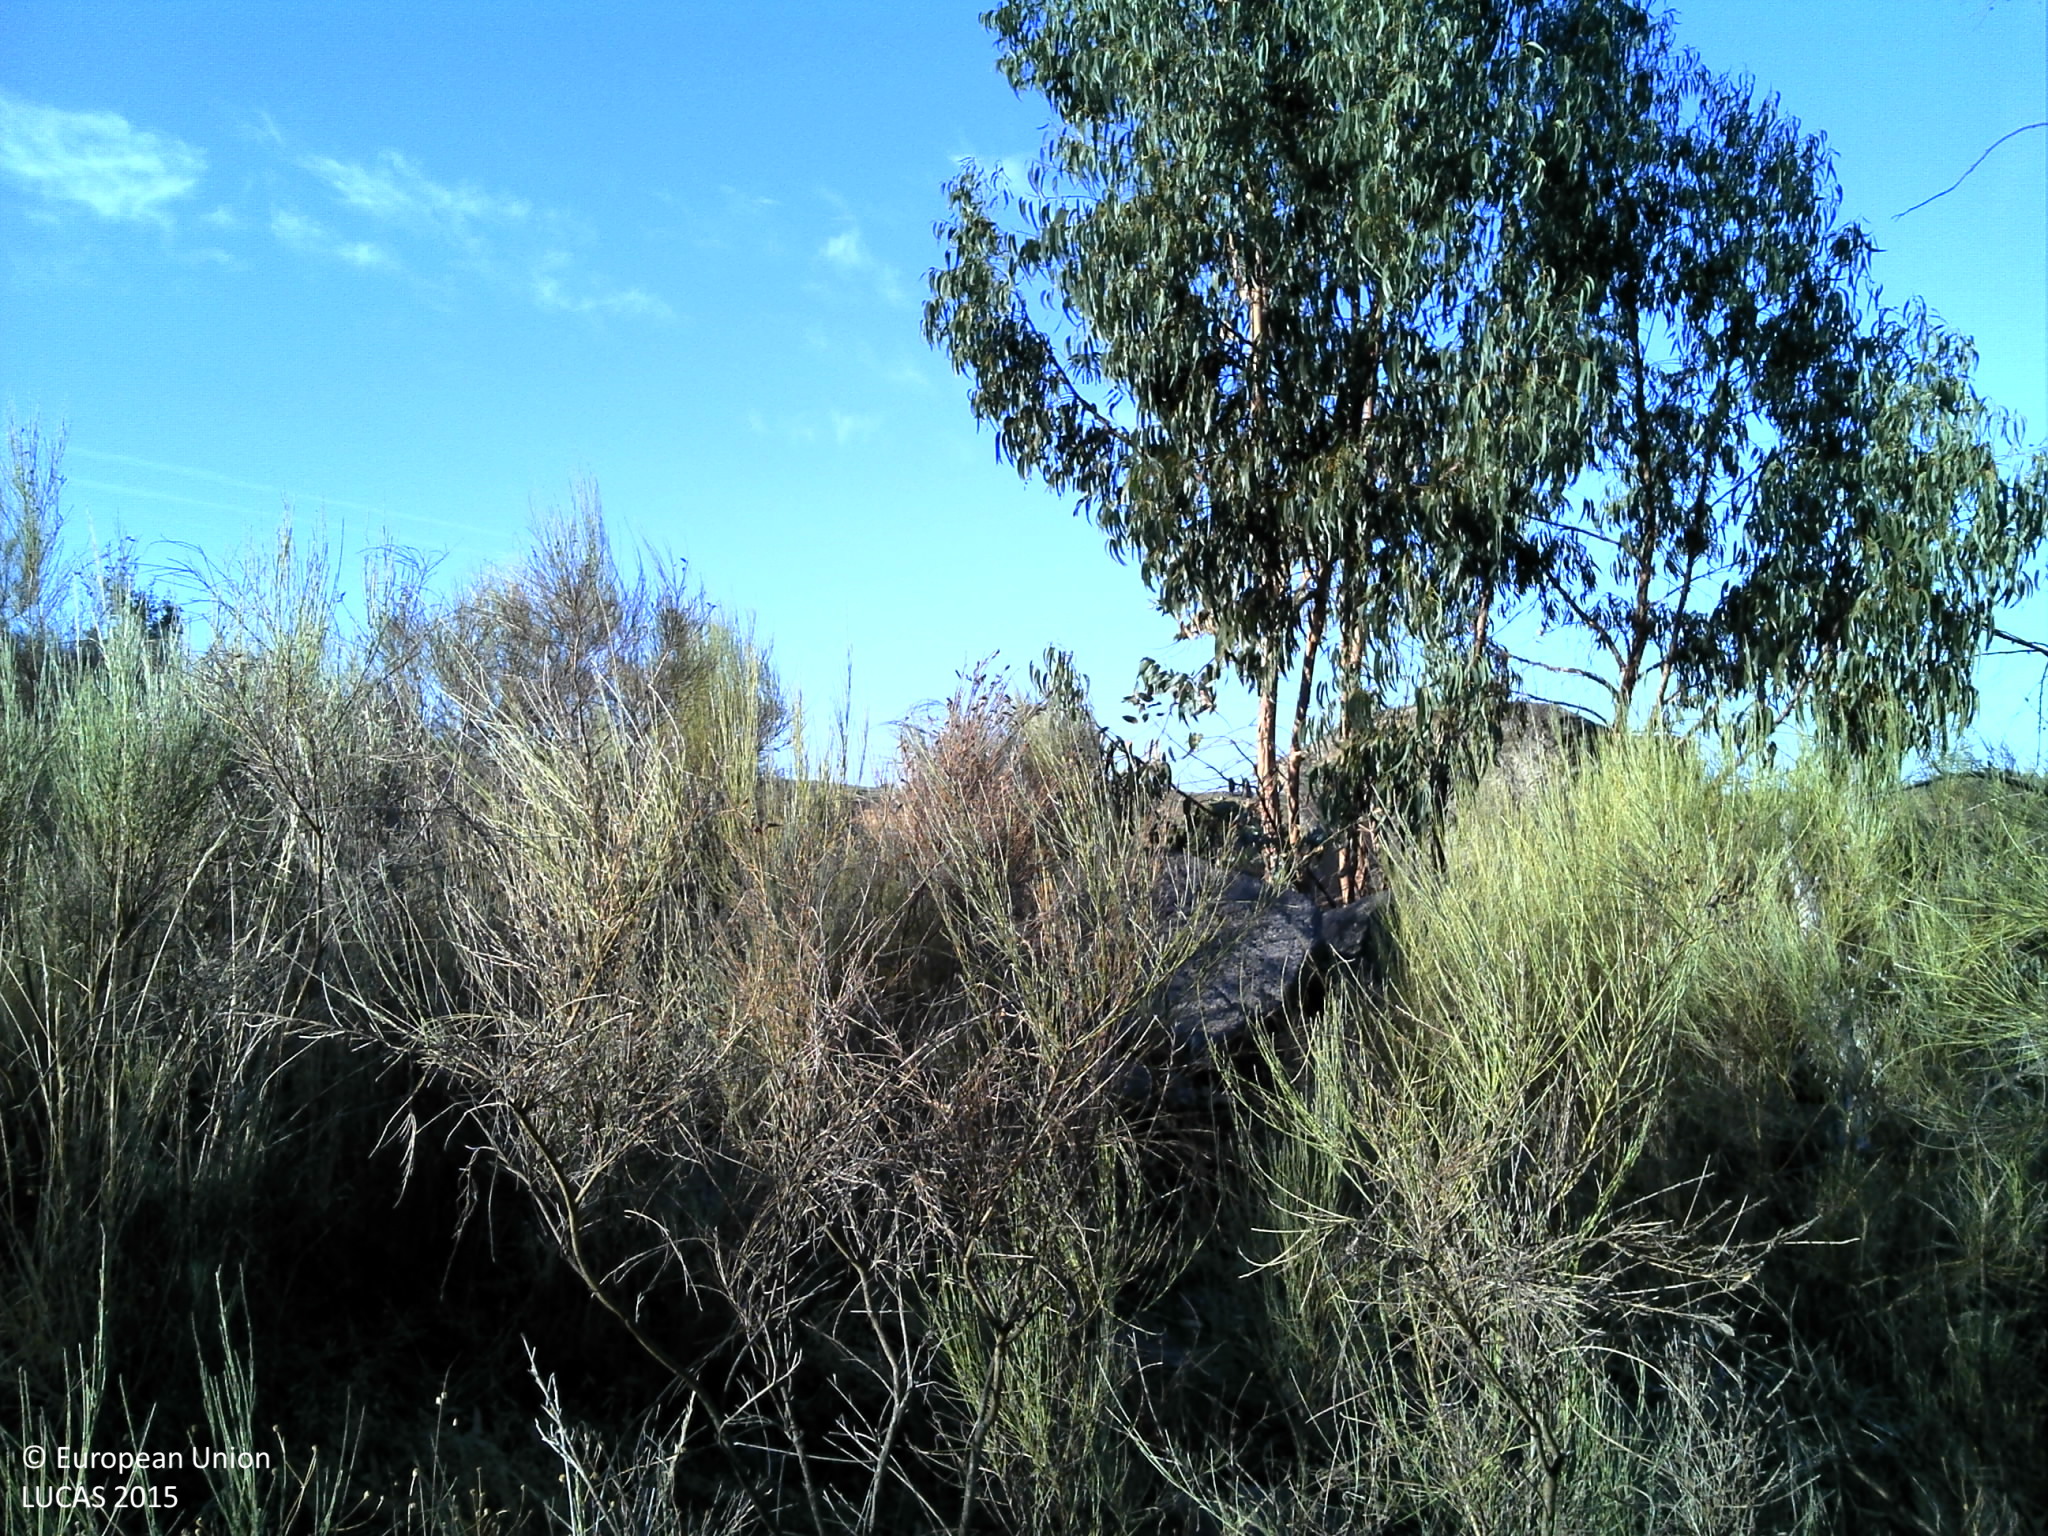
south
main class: Woodland
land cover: Broadleaved woodland
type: broadleaved evergreen forest
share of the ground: 10 - 25 %
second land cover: Shrubland without tree cover
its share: 25 - 50 %
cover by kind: shrubs 45 %, consolidated bare surface 20 %, broadleaved forest trees 15 %, herbaceous plants 15 %, unconsolidated bare surface 5 %
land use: Forestry
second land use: Agriculture (excluding fallow land and kitchen gardens)
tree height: > 5 m
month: August
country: PT
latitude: 39.4536
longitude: -7.5130
